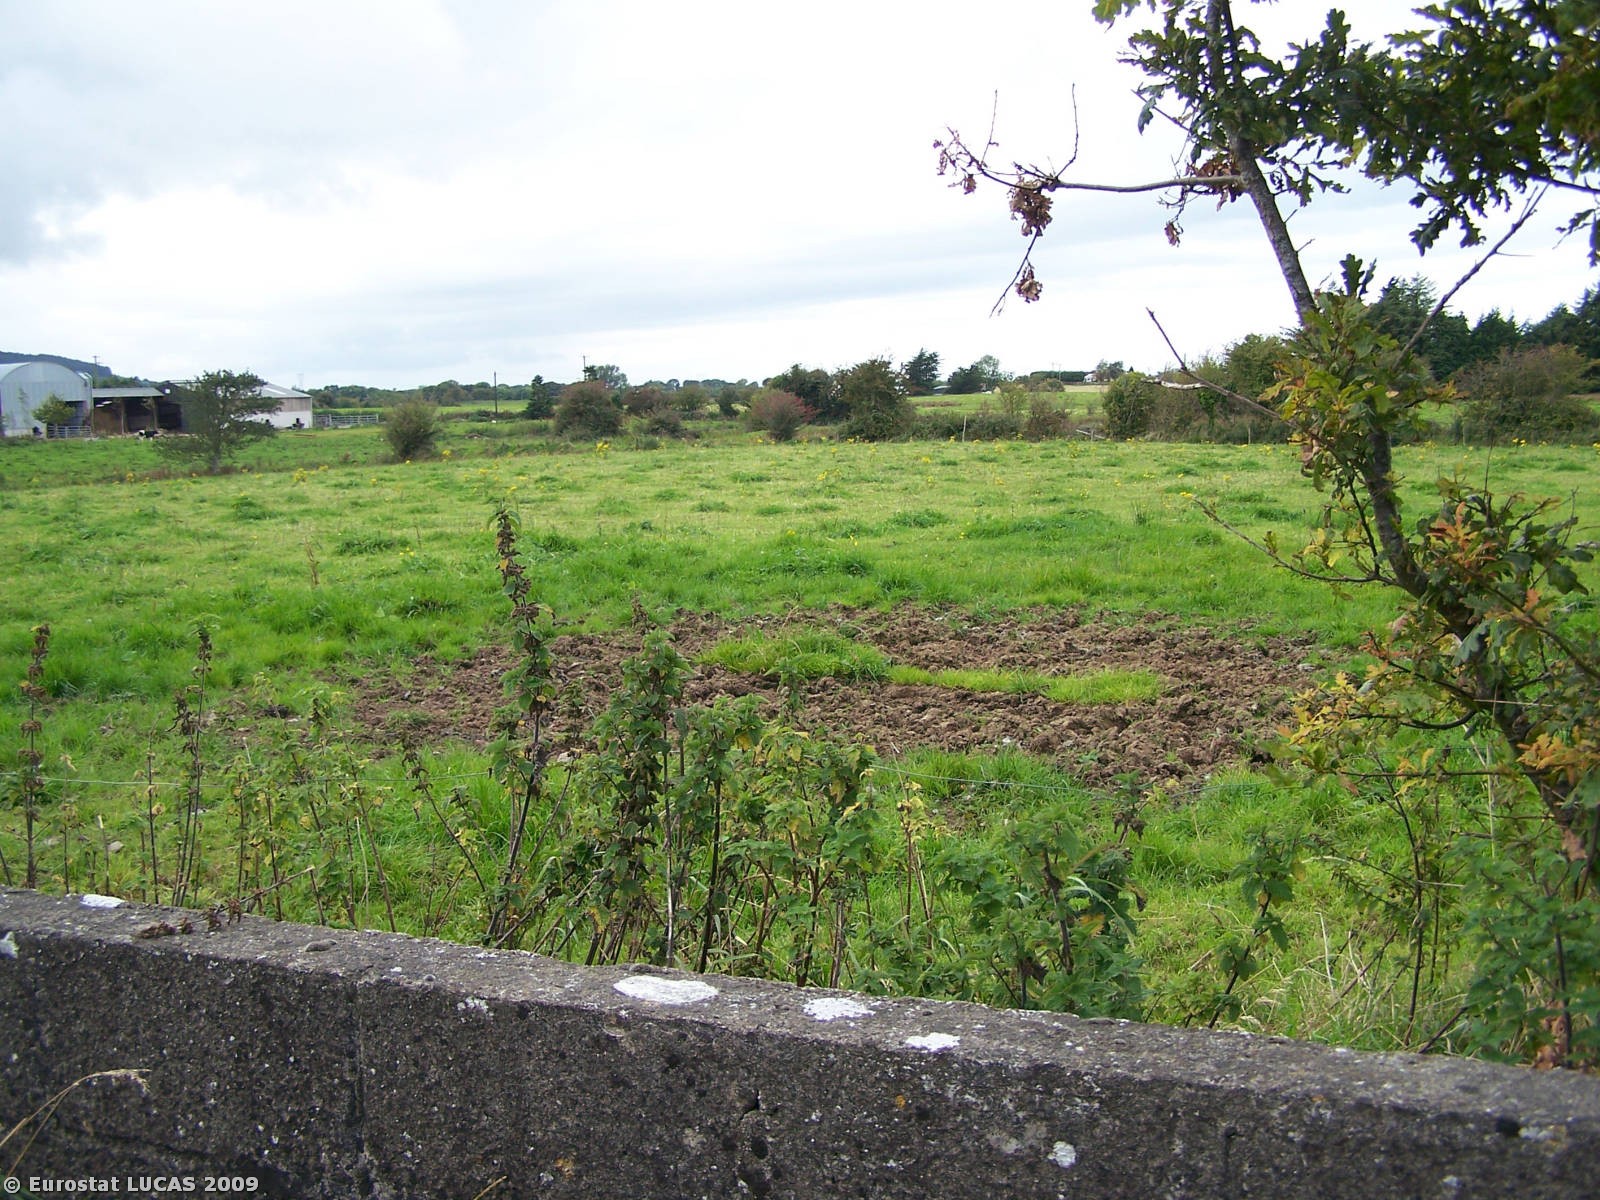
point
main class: Grassland
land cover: Grassland without tree/shrub cover
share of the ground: > 75 %
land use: Agriculture (excluding fallow land and kitchen gardens)
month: September
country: IE
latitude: 52.4027
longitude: -8.3711
